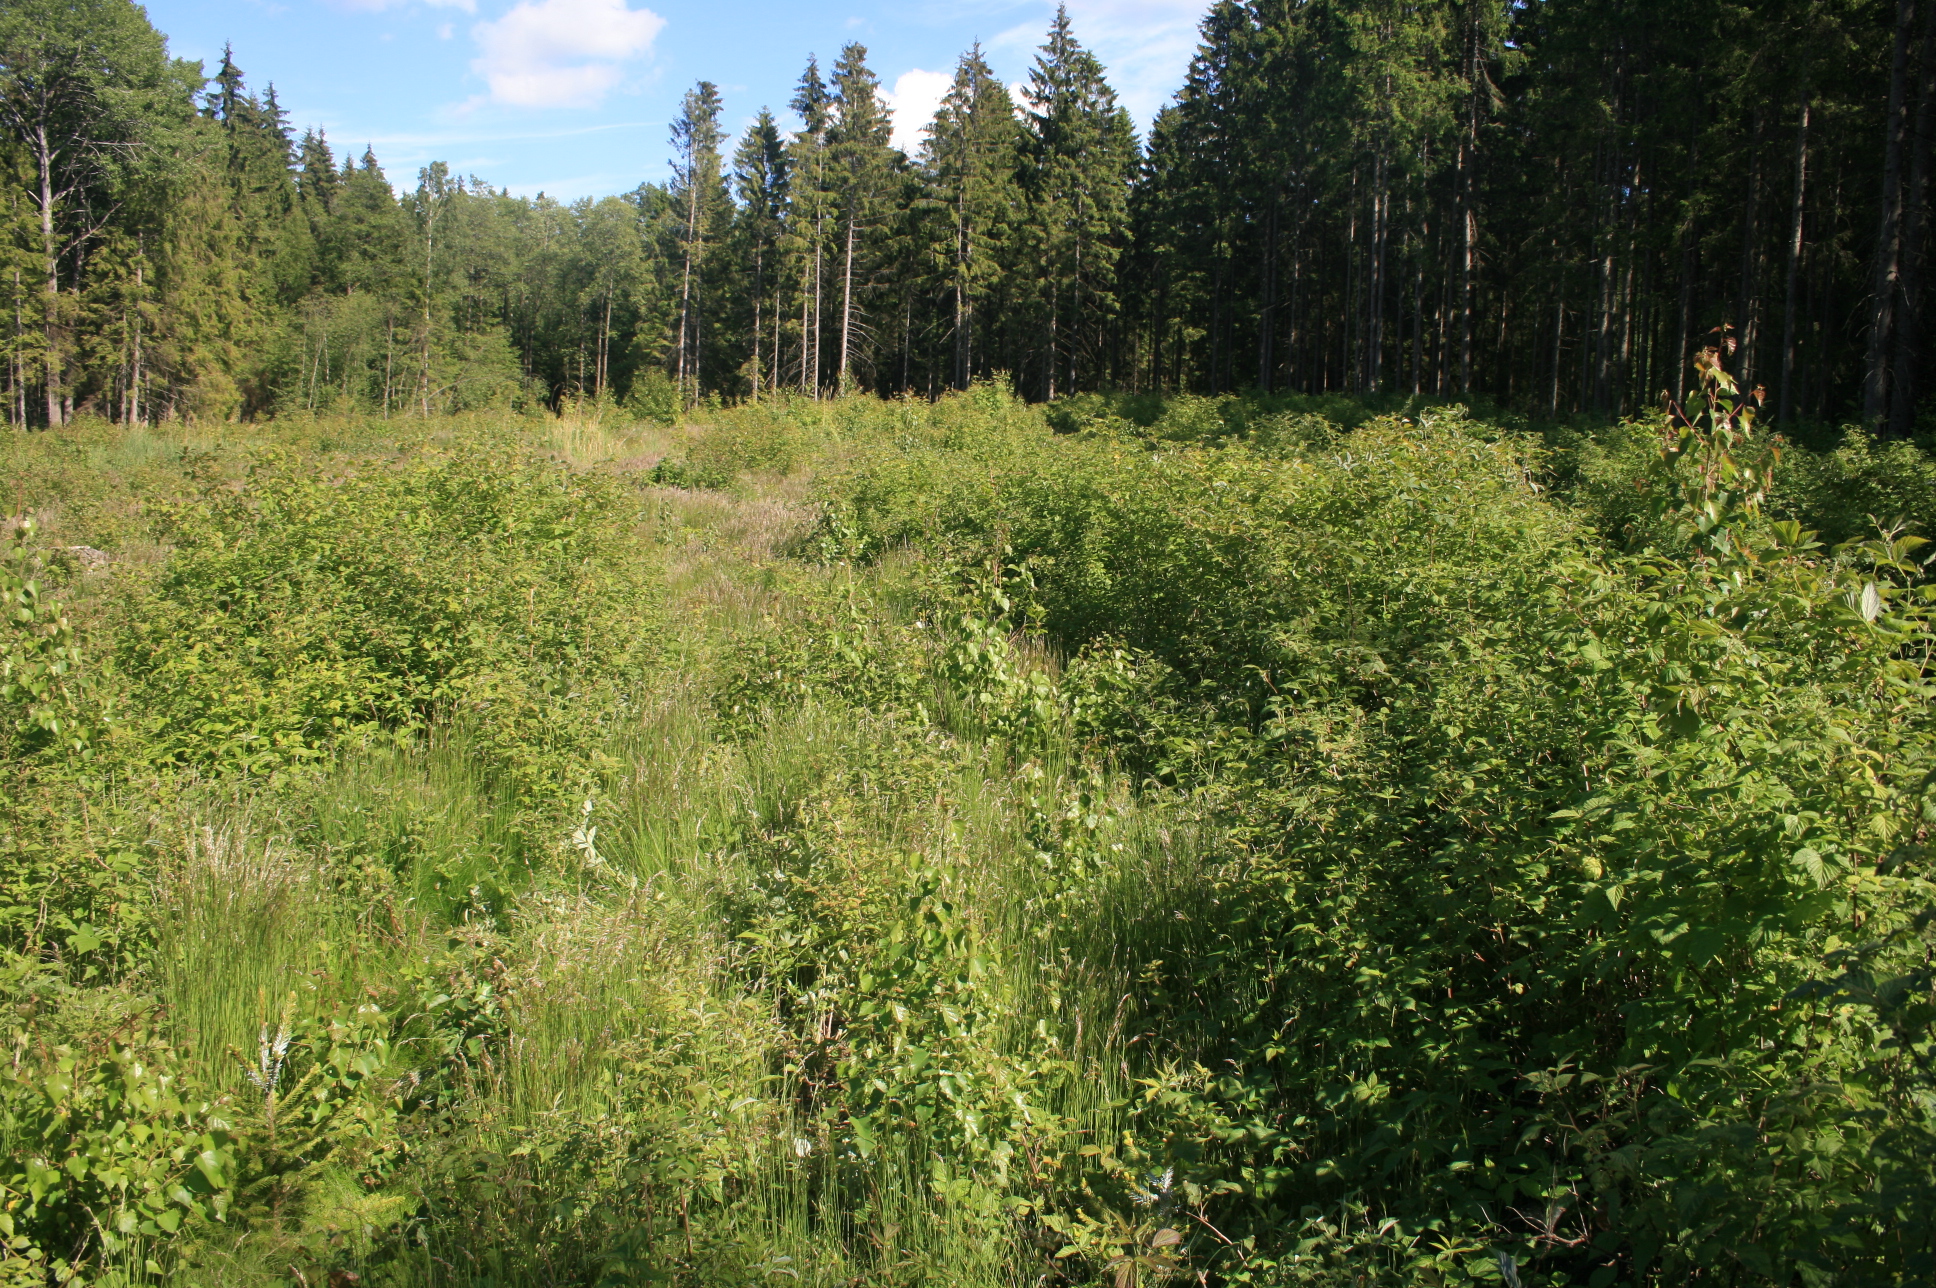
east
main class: Shrubland
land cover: Shrubland with sparse tree cover
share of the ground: > 75 %
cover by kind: shrubs 80 %, herbaceous plants 15 %, broadleaved forest trees 5 %
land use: Forestry
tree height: < 5 m
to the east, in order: Shrubland with sparse tree cover; Spruce dominated coniferous woodland; Shrubland with sparse tree cover; Spruce dominated coniferous woodland
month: June
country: LT
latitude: 55.8152
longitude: 22.2644
